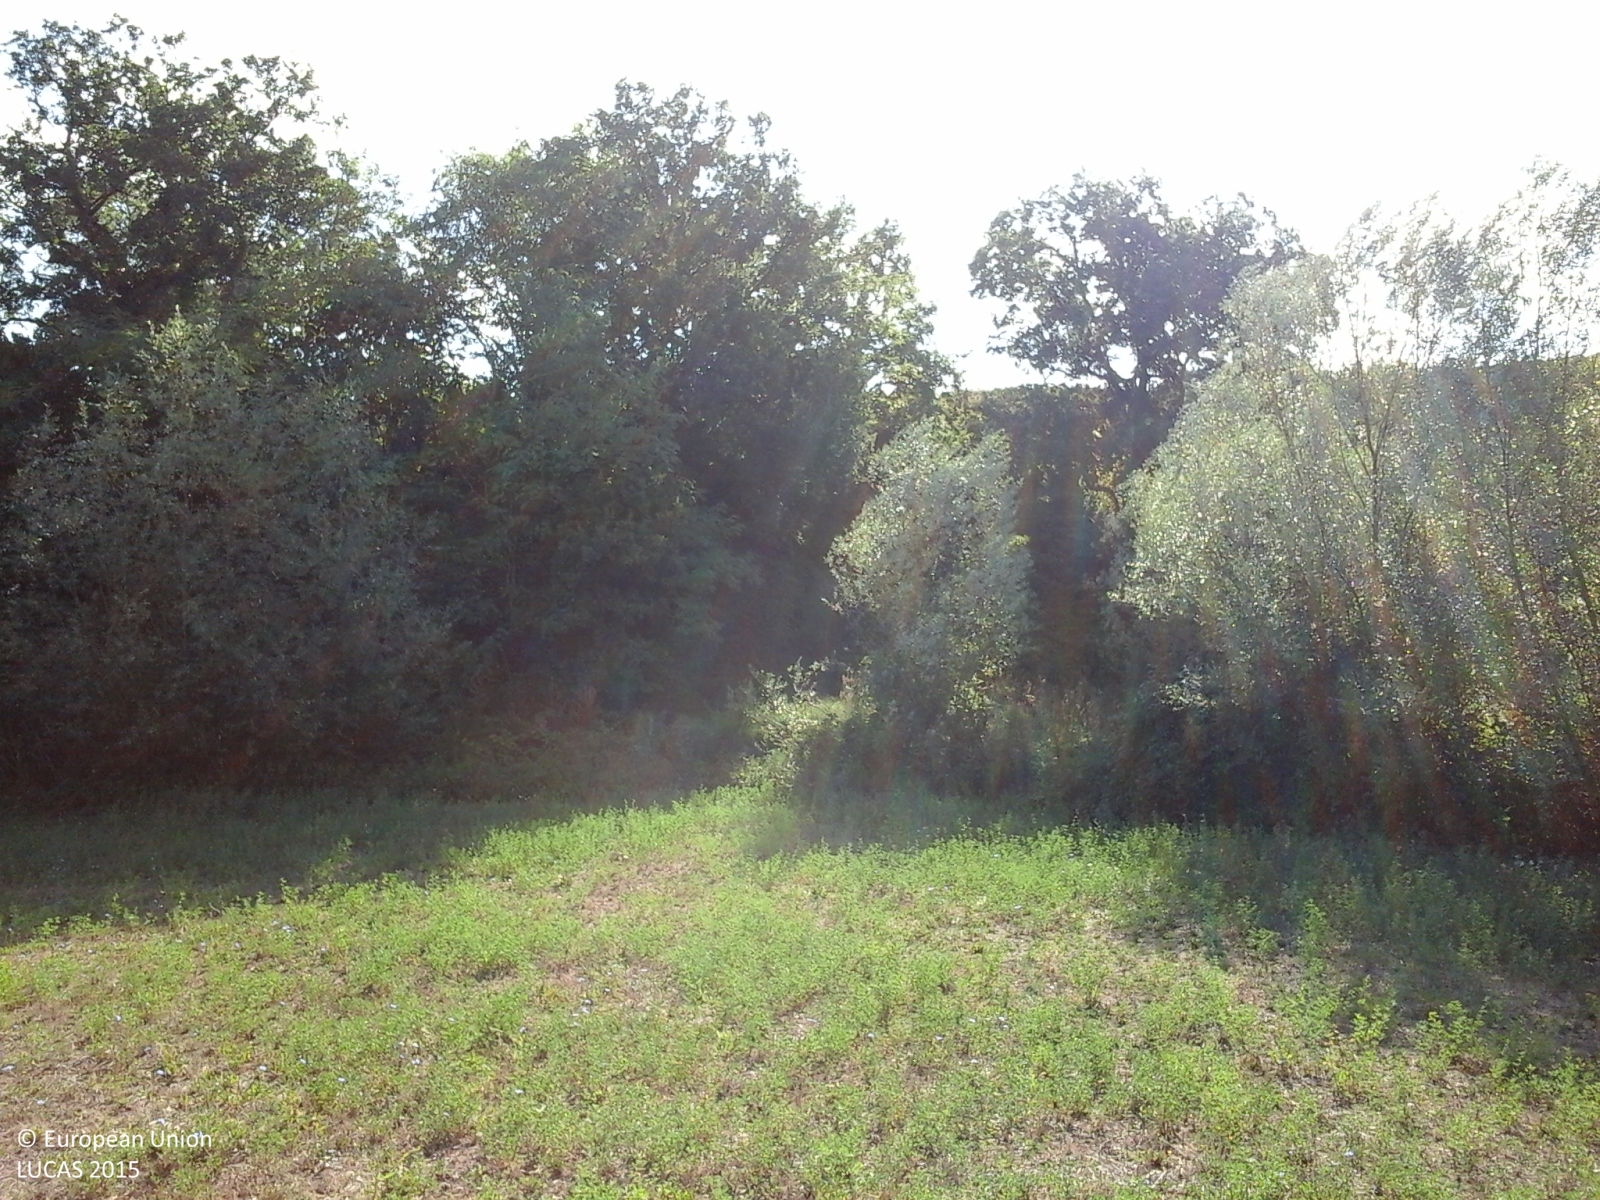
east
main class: Cropland
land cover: Clovers
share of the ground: > 75 %
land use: Agriculture (excluding fallow land and kitchen gardens)
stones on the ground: 10 - 25 %
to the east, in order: Clovers; Electric lines; Clovers; Broadleaved woodland; Oats; Electric lines; Oats; Grass margins; Paved roads, cycling and walking lanes; Broadleaved woodland; Inland fresh running water; Broadleaved woodland; Dry pulses; Grass margins; Paved roads, cycling and walking lanes; Broadleaved woodland
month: September
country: IT
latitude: 43.2417
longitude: 13.0091
